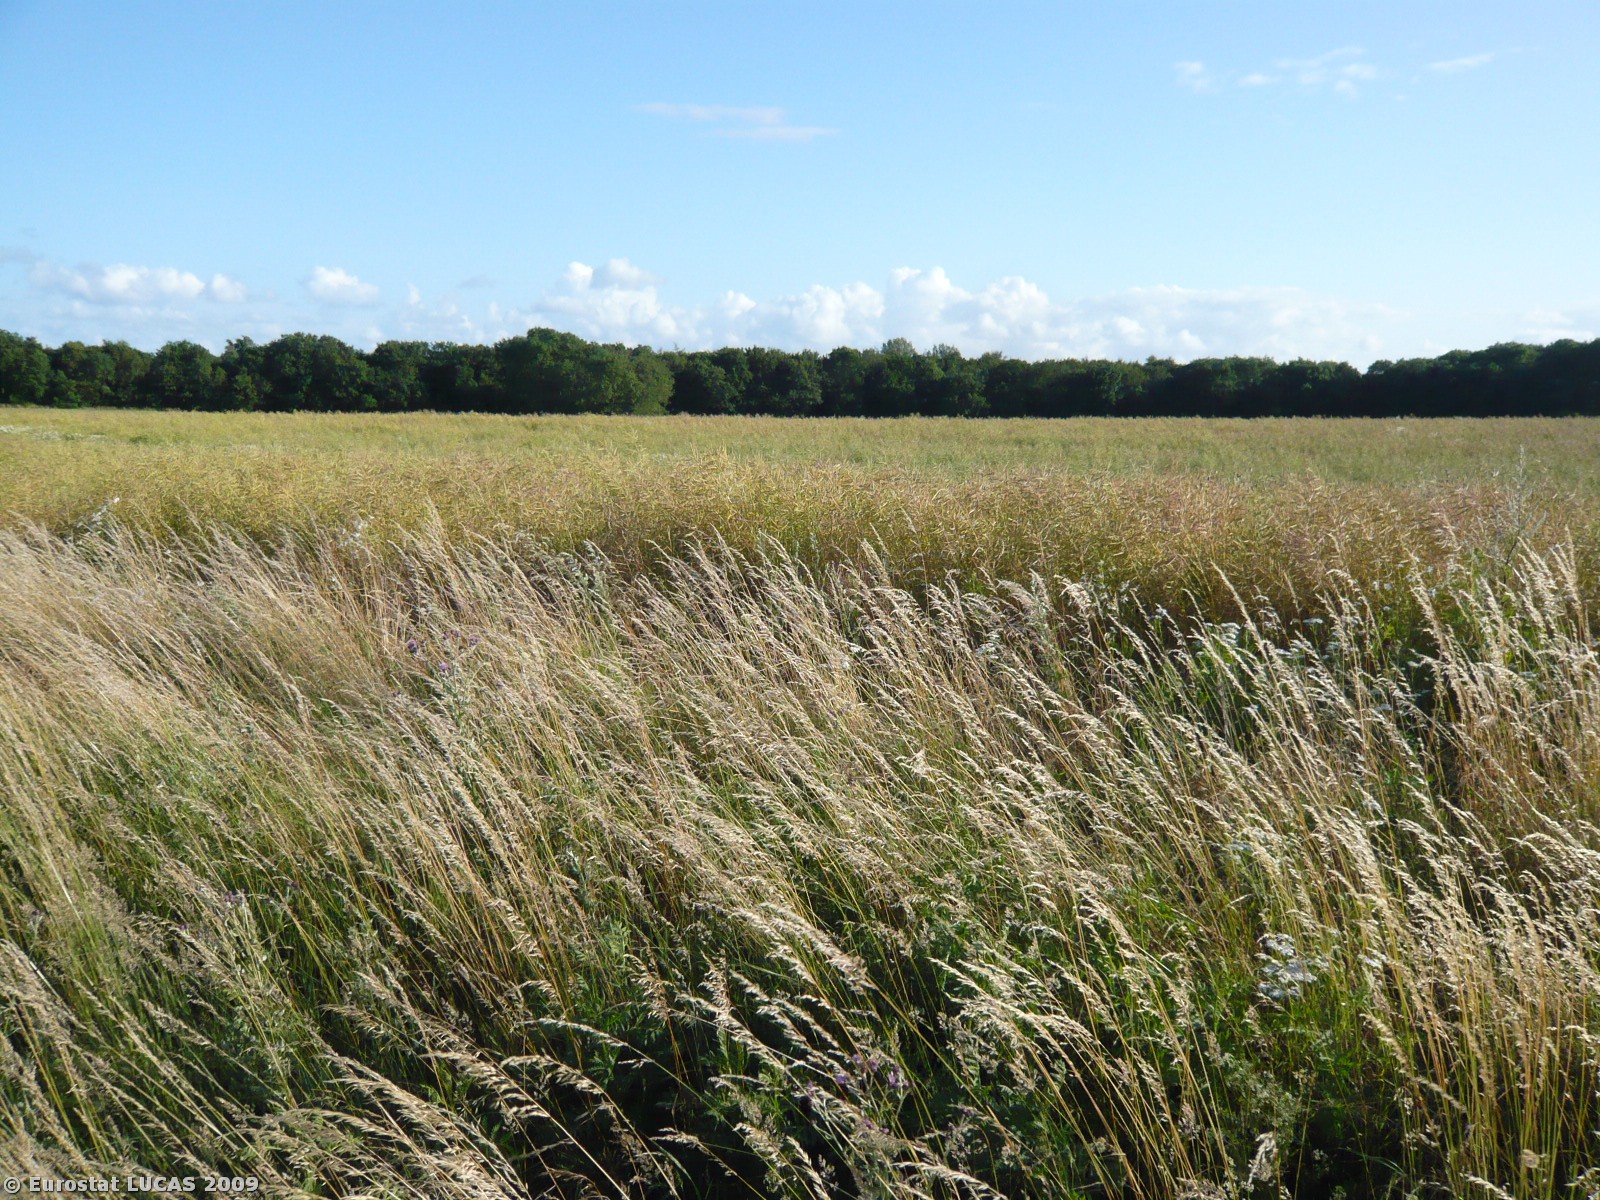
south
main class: Grassland
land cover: Grassland without tree/shrub cover
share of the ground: > 75 %
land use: Unused
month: July
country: DK
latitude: 55.3226
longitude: 10.7715
